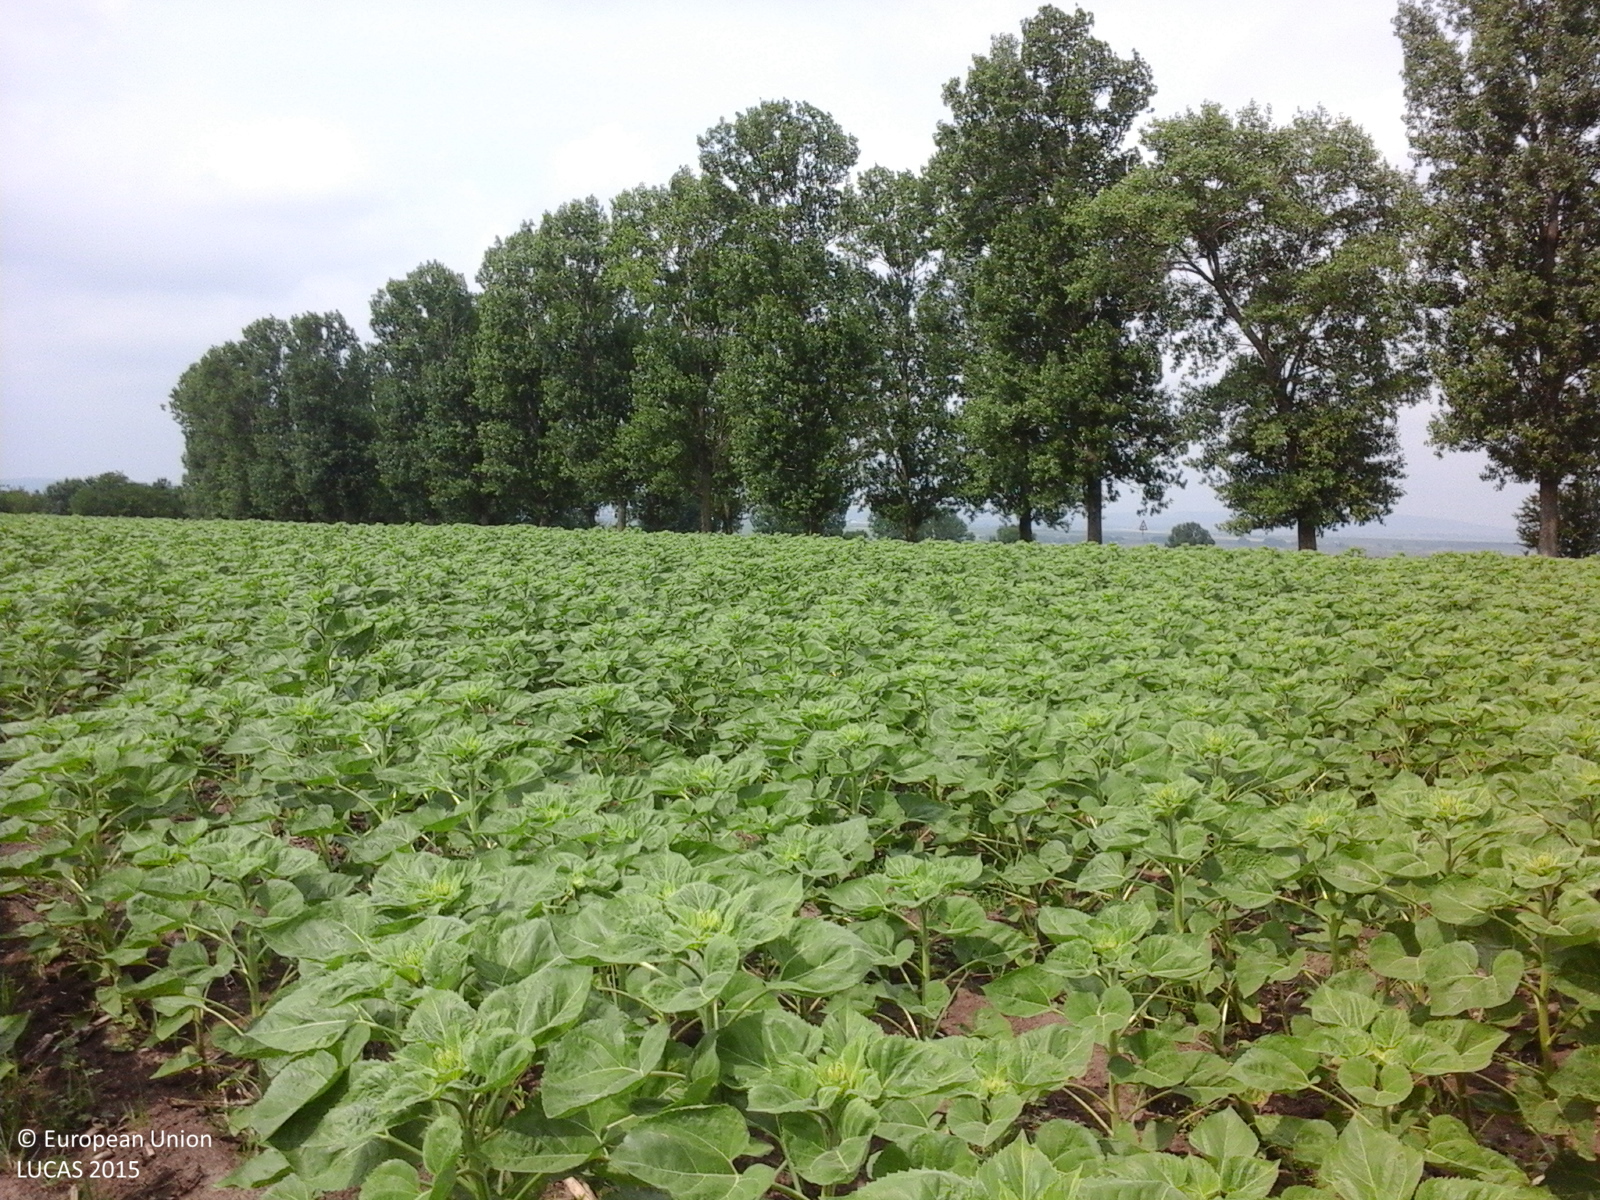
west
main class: Cropland
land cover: Sunflower
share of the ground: > 75 %
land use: Agriculture (excluding fallow land and kitchen gardens)
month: June
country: RO
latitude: 47.7888
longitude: 26.6606
